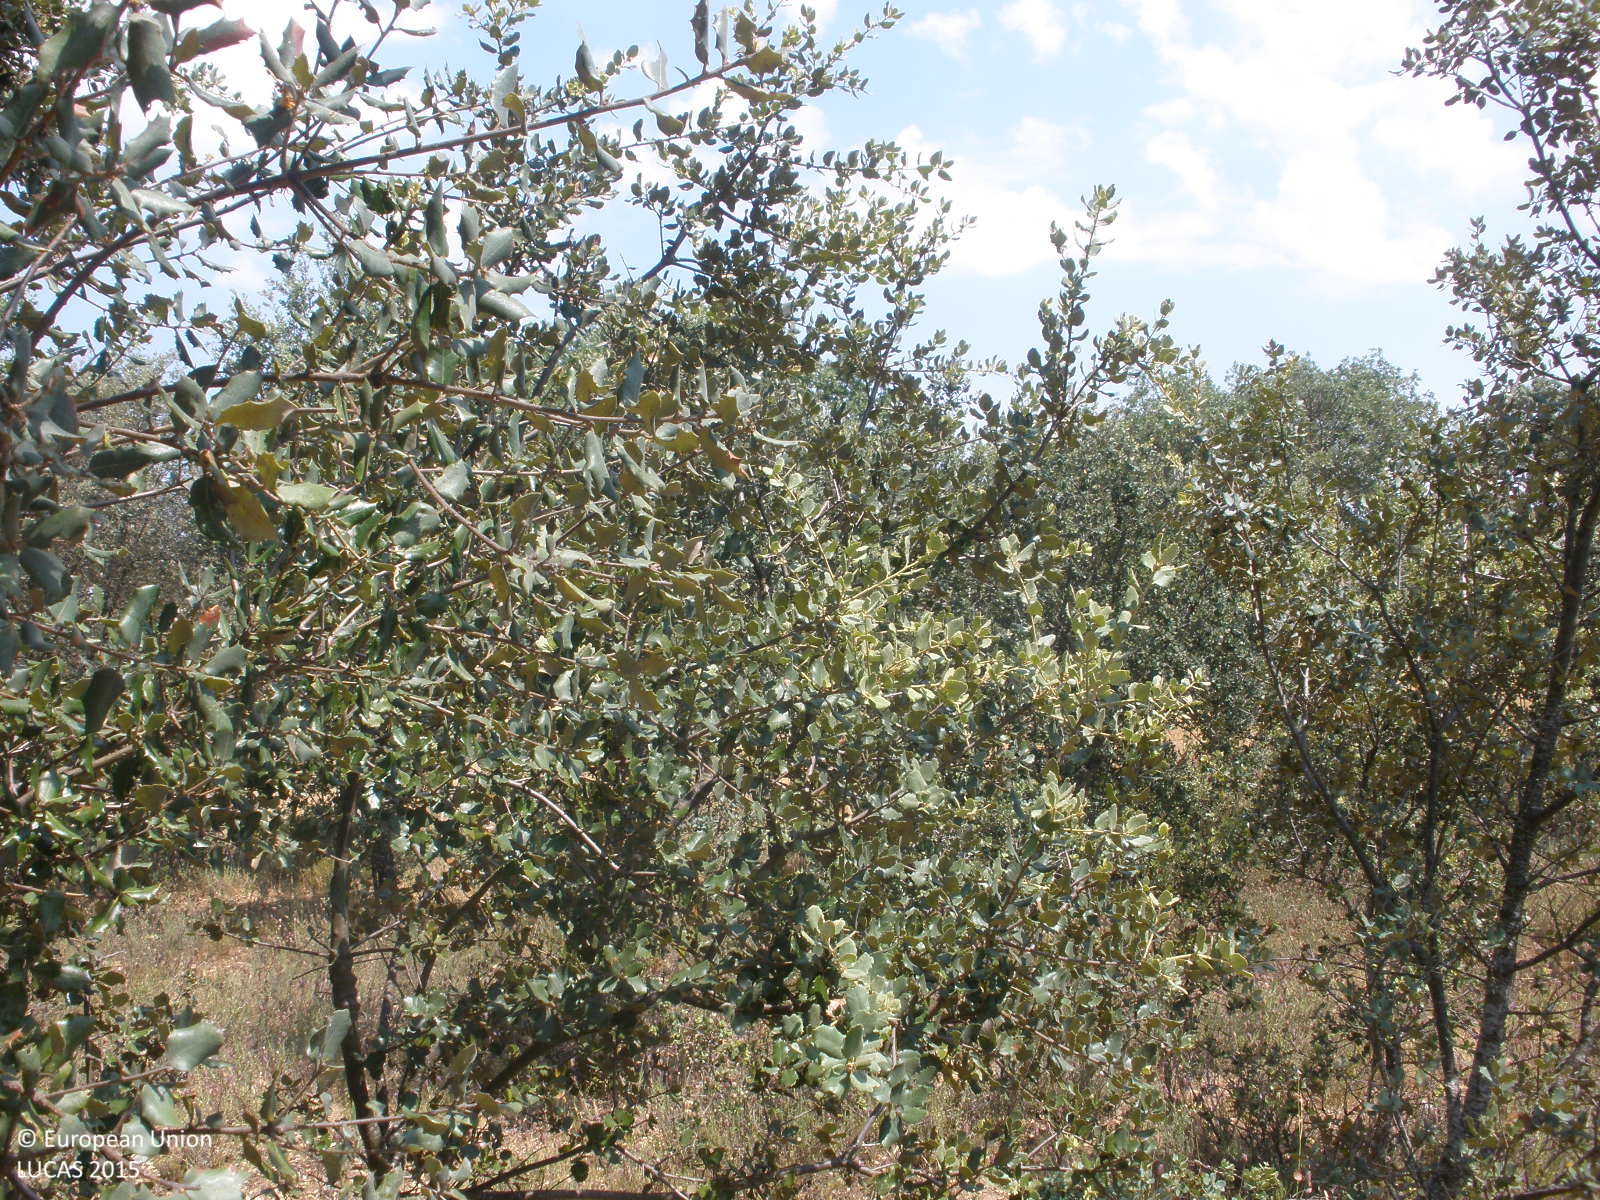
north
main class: Woodland
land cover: Broadleaved woodland
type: broadleaved evergreen forest
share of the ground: > 75 %
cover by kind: broadleaved forest trees 40 %, shrubs 40 %, herbaceous plants 20 %
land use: Forestry
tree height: > 5 m
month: June
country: ES
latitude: 40.6431
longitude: -6.2974
